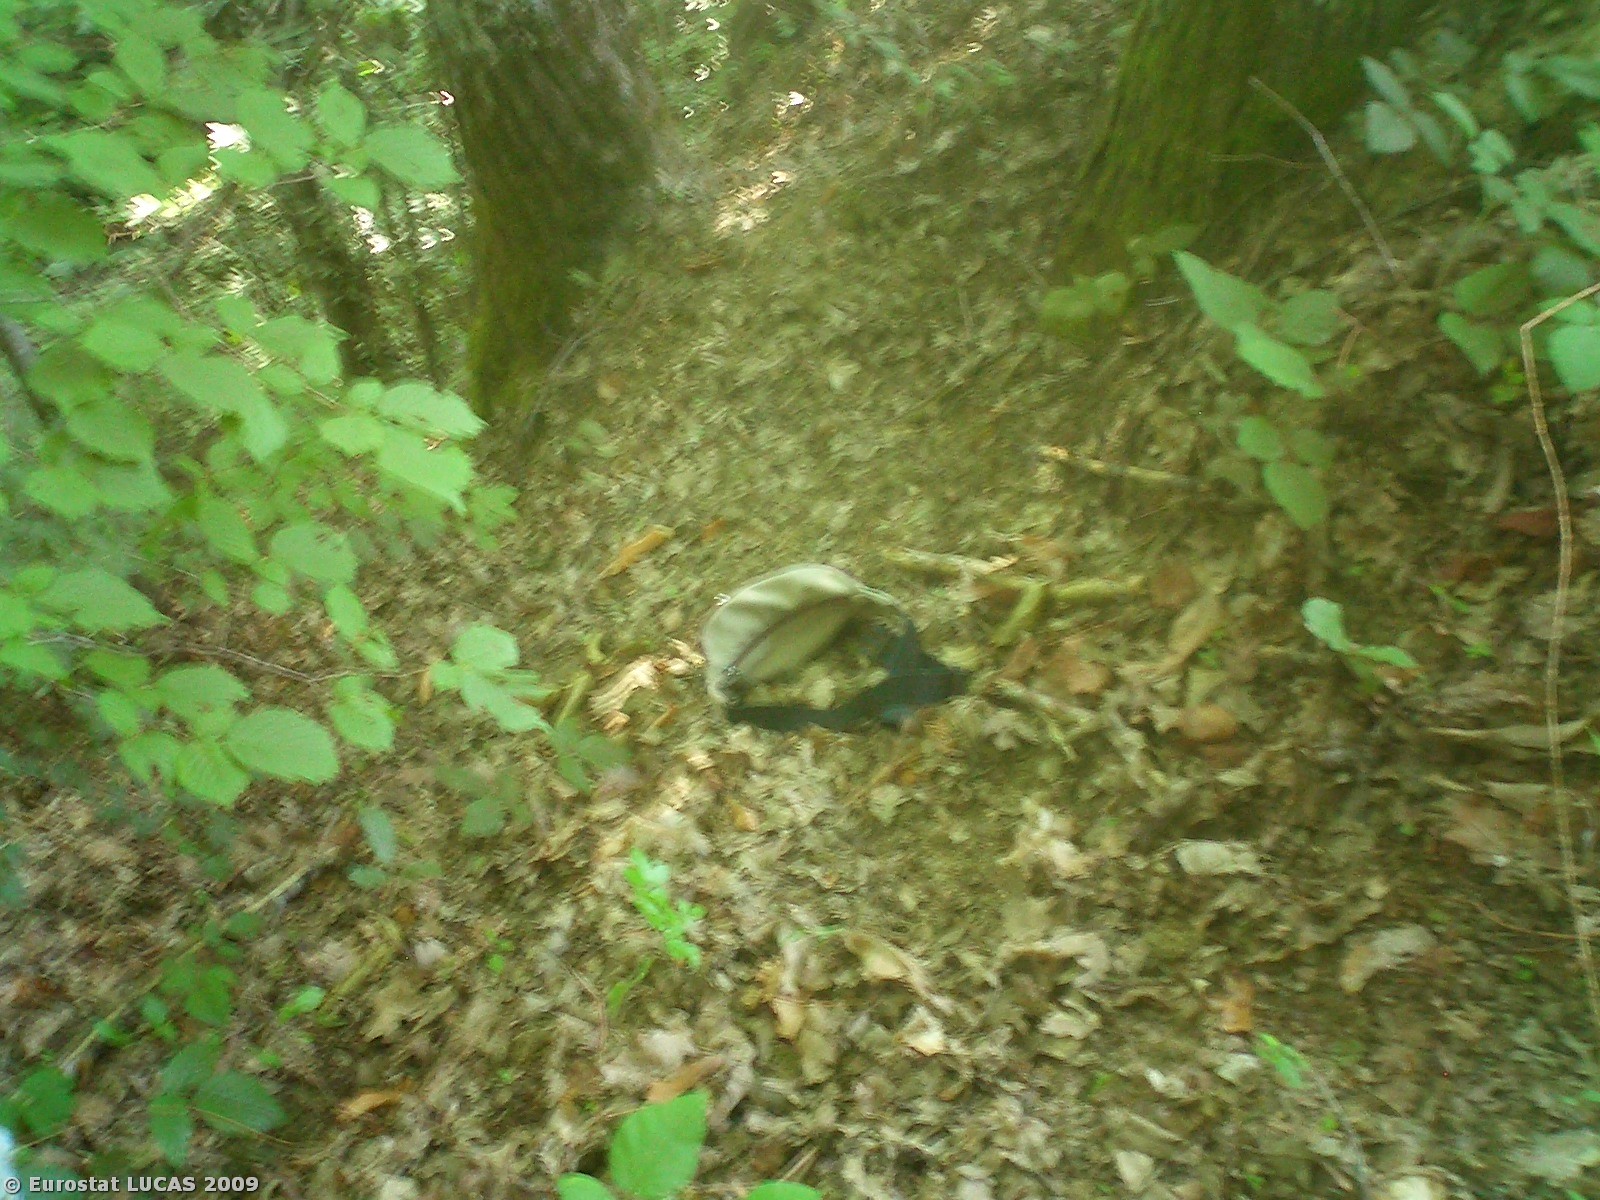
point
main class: Woodland
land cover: Broadleaved woodland
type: mesophytic deciduous forest
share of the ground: > 75 %
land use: Forestry
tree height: > 5 m
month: June
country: IT
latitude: 43.7715
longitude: 12.0199
